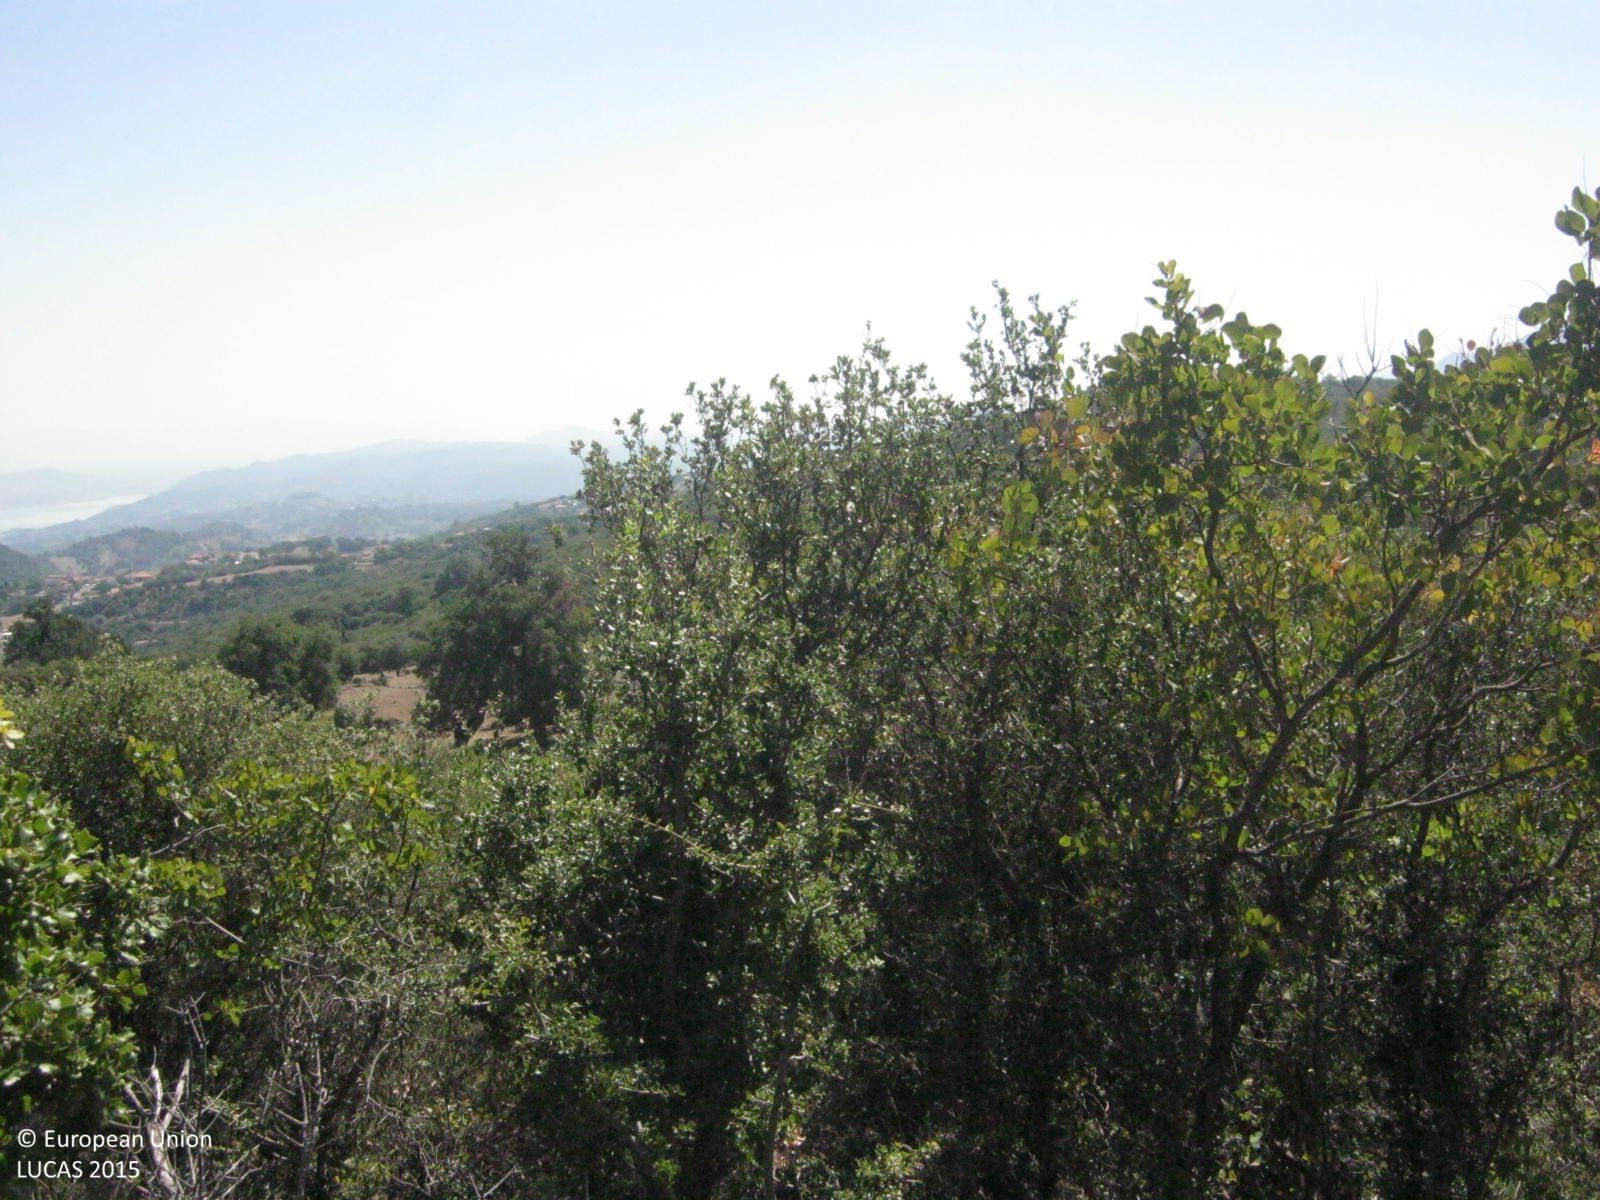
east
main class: Grassland
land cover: Grassland with sparse tree/shrub cover
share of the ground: > 75 %
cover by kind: herbaceous plants 80 %, unconsolidated bare surface 10 %, broadleaved forest trees 5 %, shrubs 5 %
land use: Agriculture (excluding fallow land and kitchen gardens)
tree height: < 5 m
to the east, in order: Grassland with sparse tree/shrub cover; Broadleaved woodland; Tracks; Broadleaved woodland
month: September
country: GR
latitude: 38.8362
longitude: 21.0645
